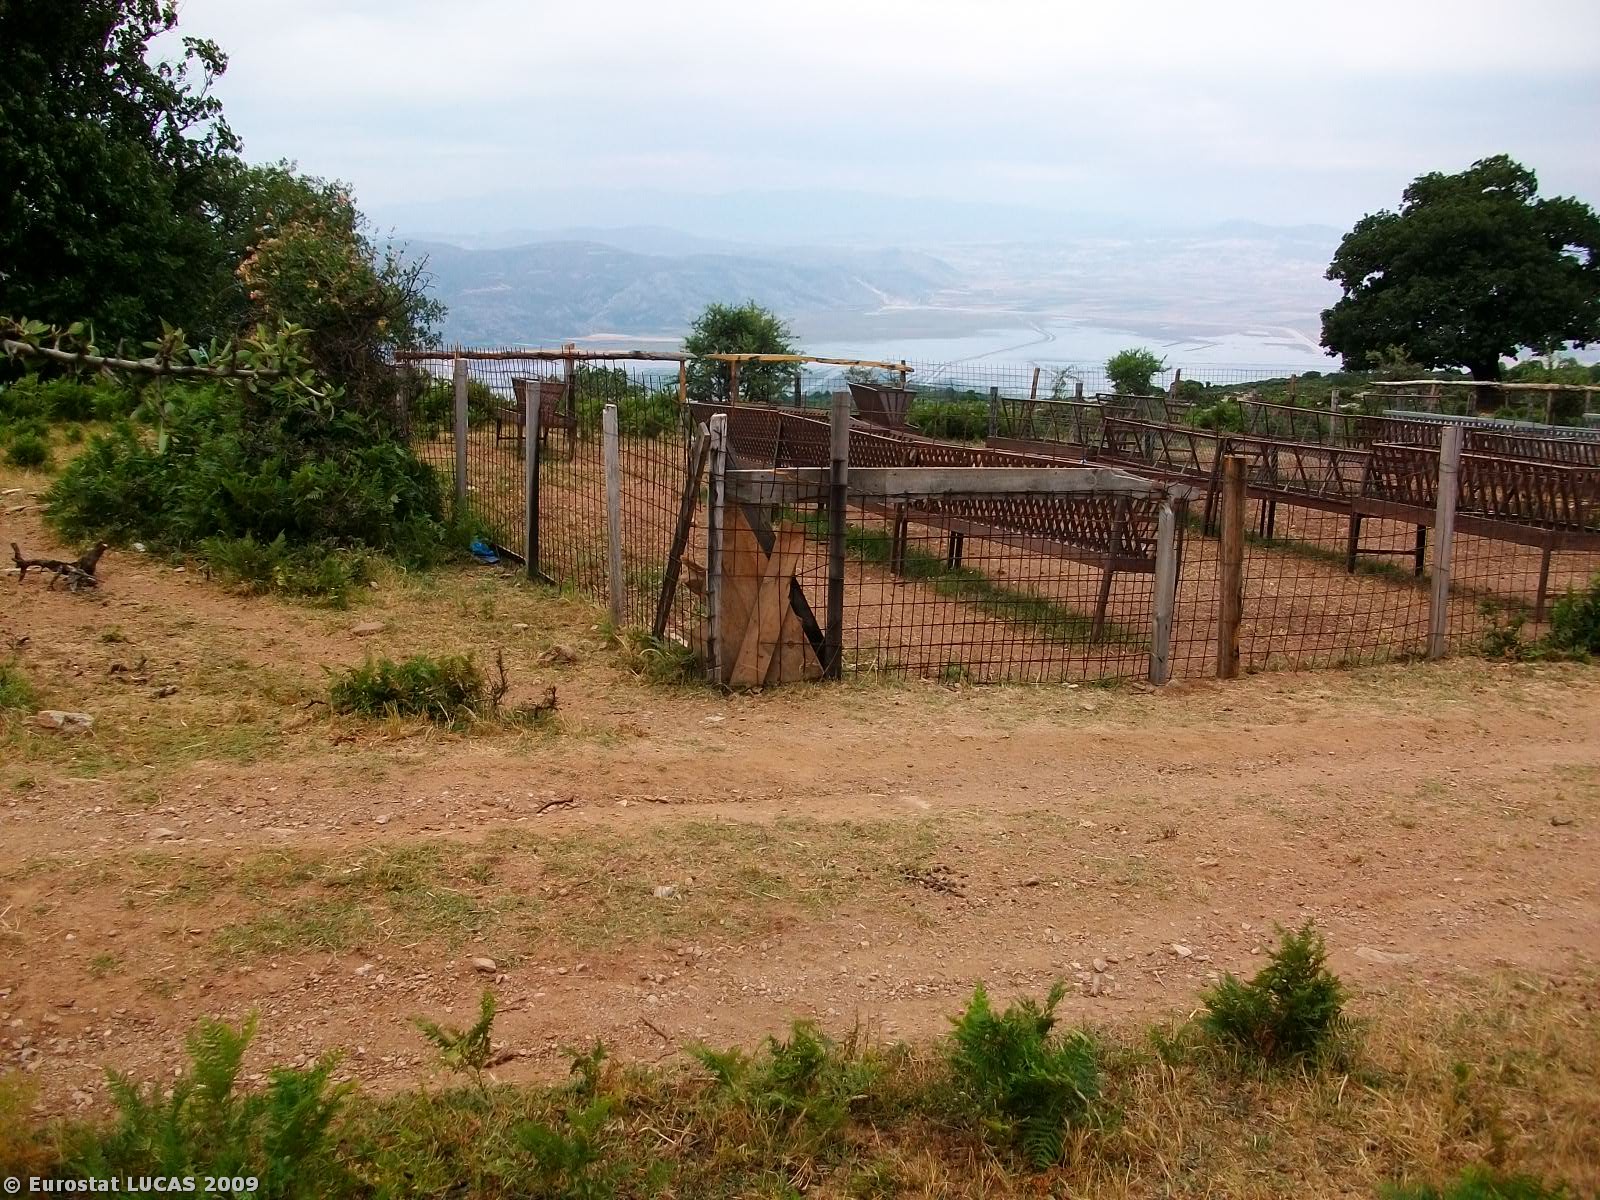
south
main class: Grassland
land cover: Grassland with sparse tree/shrub cover
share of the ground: > 75 %
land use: Agriculture (excluding fallow land and kitchen gardens)
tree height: > 5 m
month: June
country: GR
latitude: 39.5433
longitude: 22.8743
